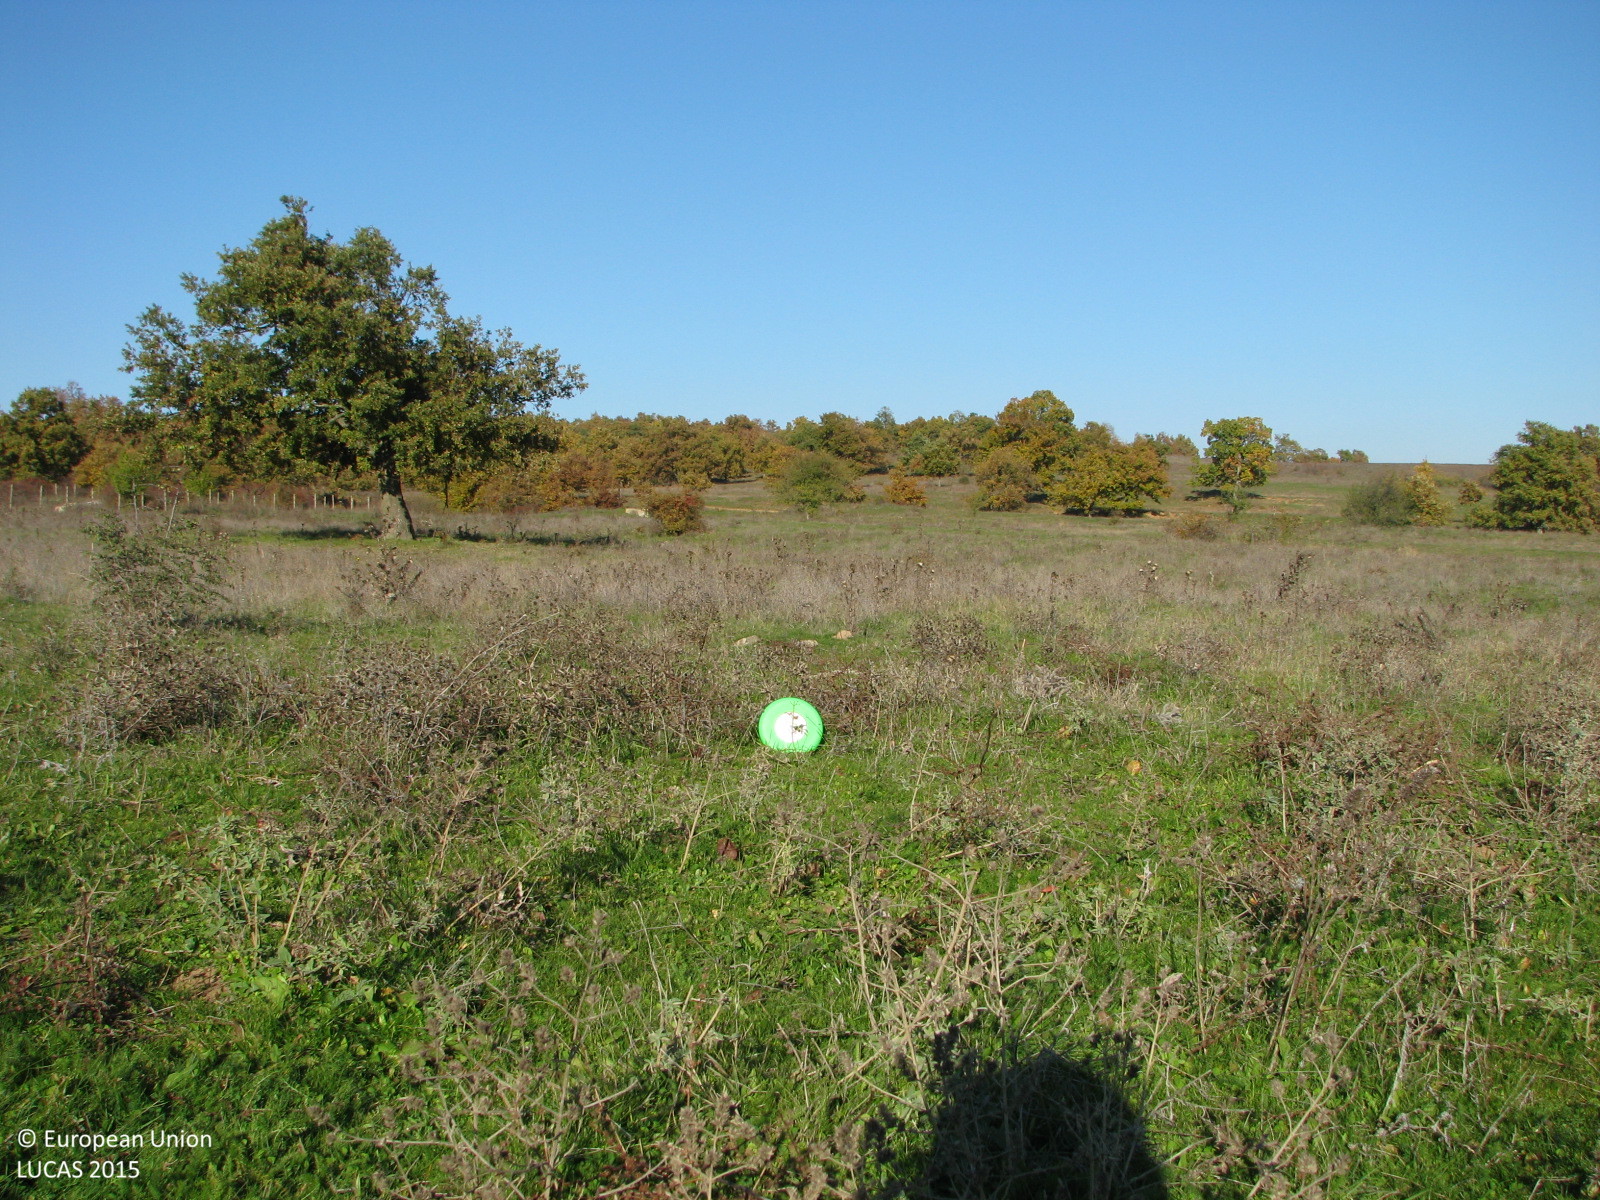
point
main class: Grassland
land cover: Grassland without tree/shrub cover
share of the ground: > 75 %
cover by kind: herbaceous plants 100 %
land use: Agriculture (excluding fallow land and kitchen gardens)
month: November
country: BG
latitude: 42.0659
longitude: 26.8079
